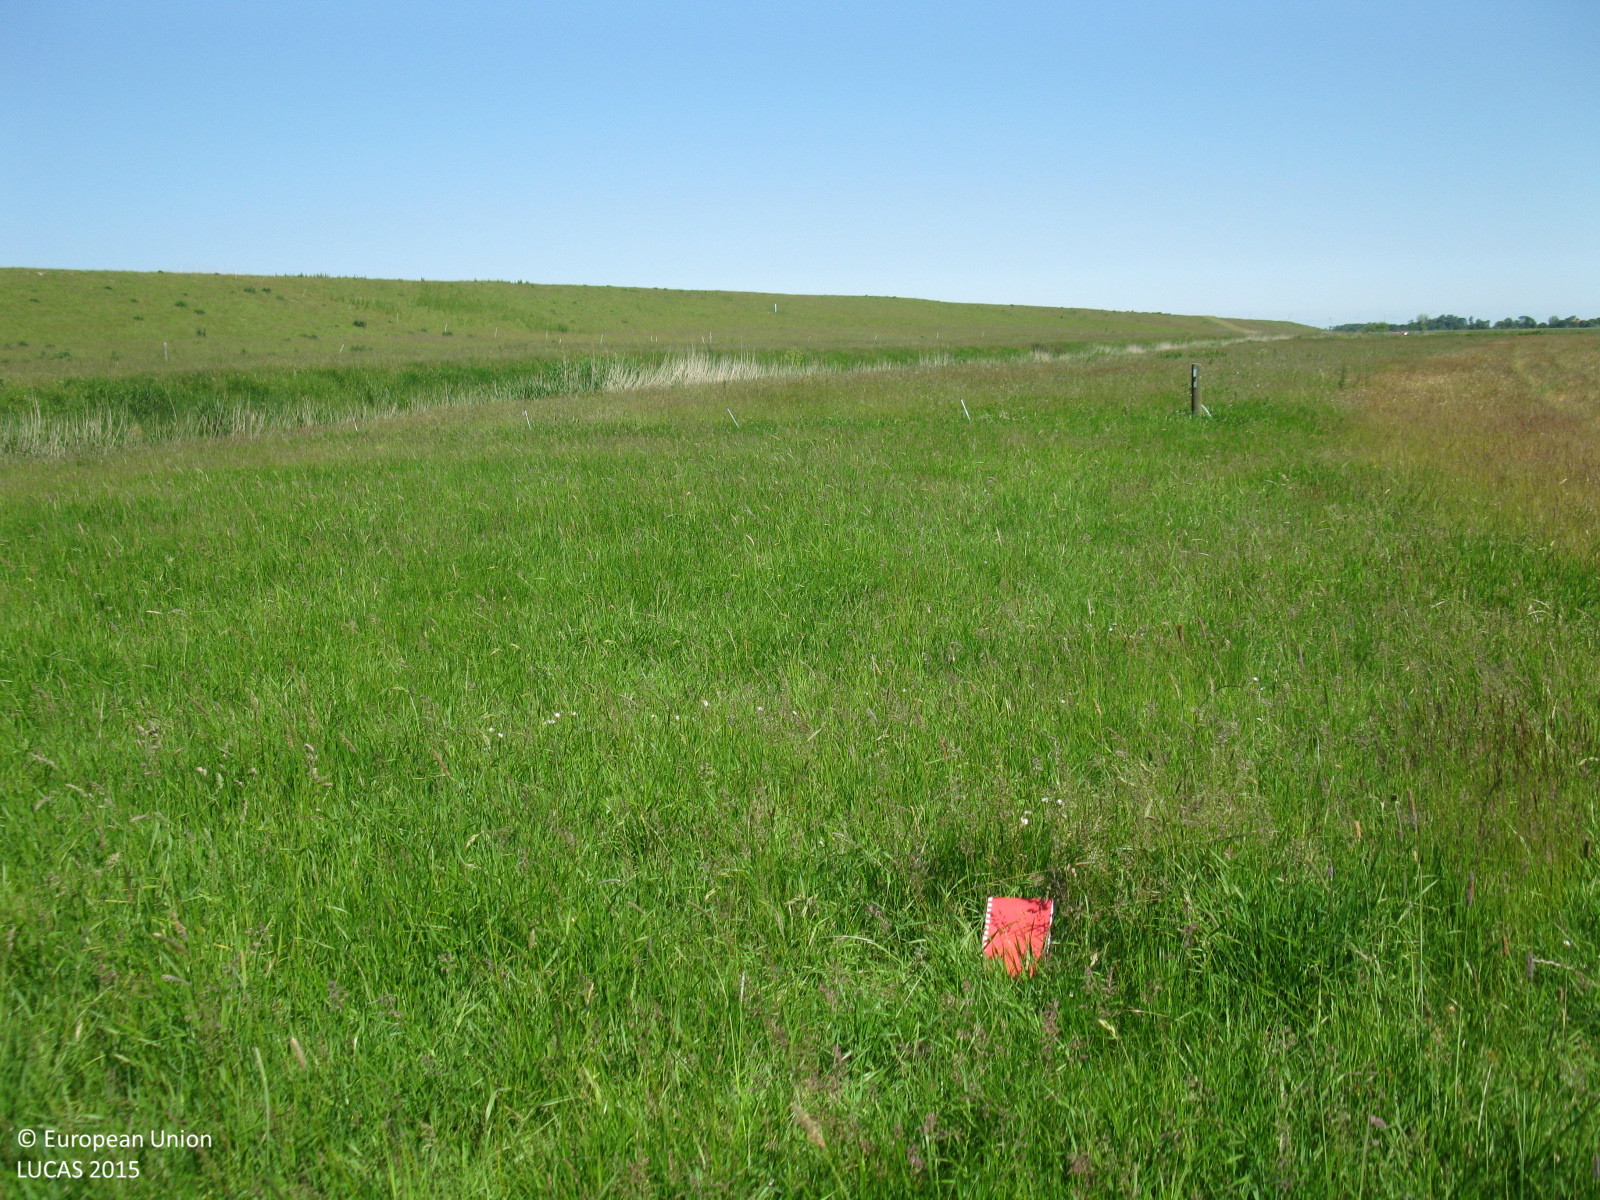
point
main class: Grassland
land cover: Grassland without tree/shrub cover
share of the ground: > 75 %
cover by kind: herbaceous plants 100 %
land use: Agriculture (excluding fallow land and kitchen gardens)
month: June
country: DE
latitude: 53.4982
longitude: 8.3274
